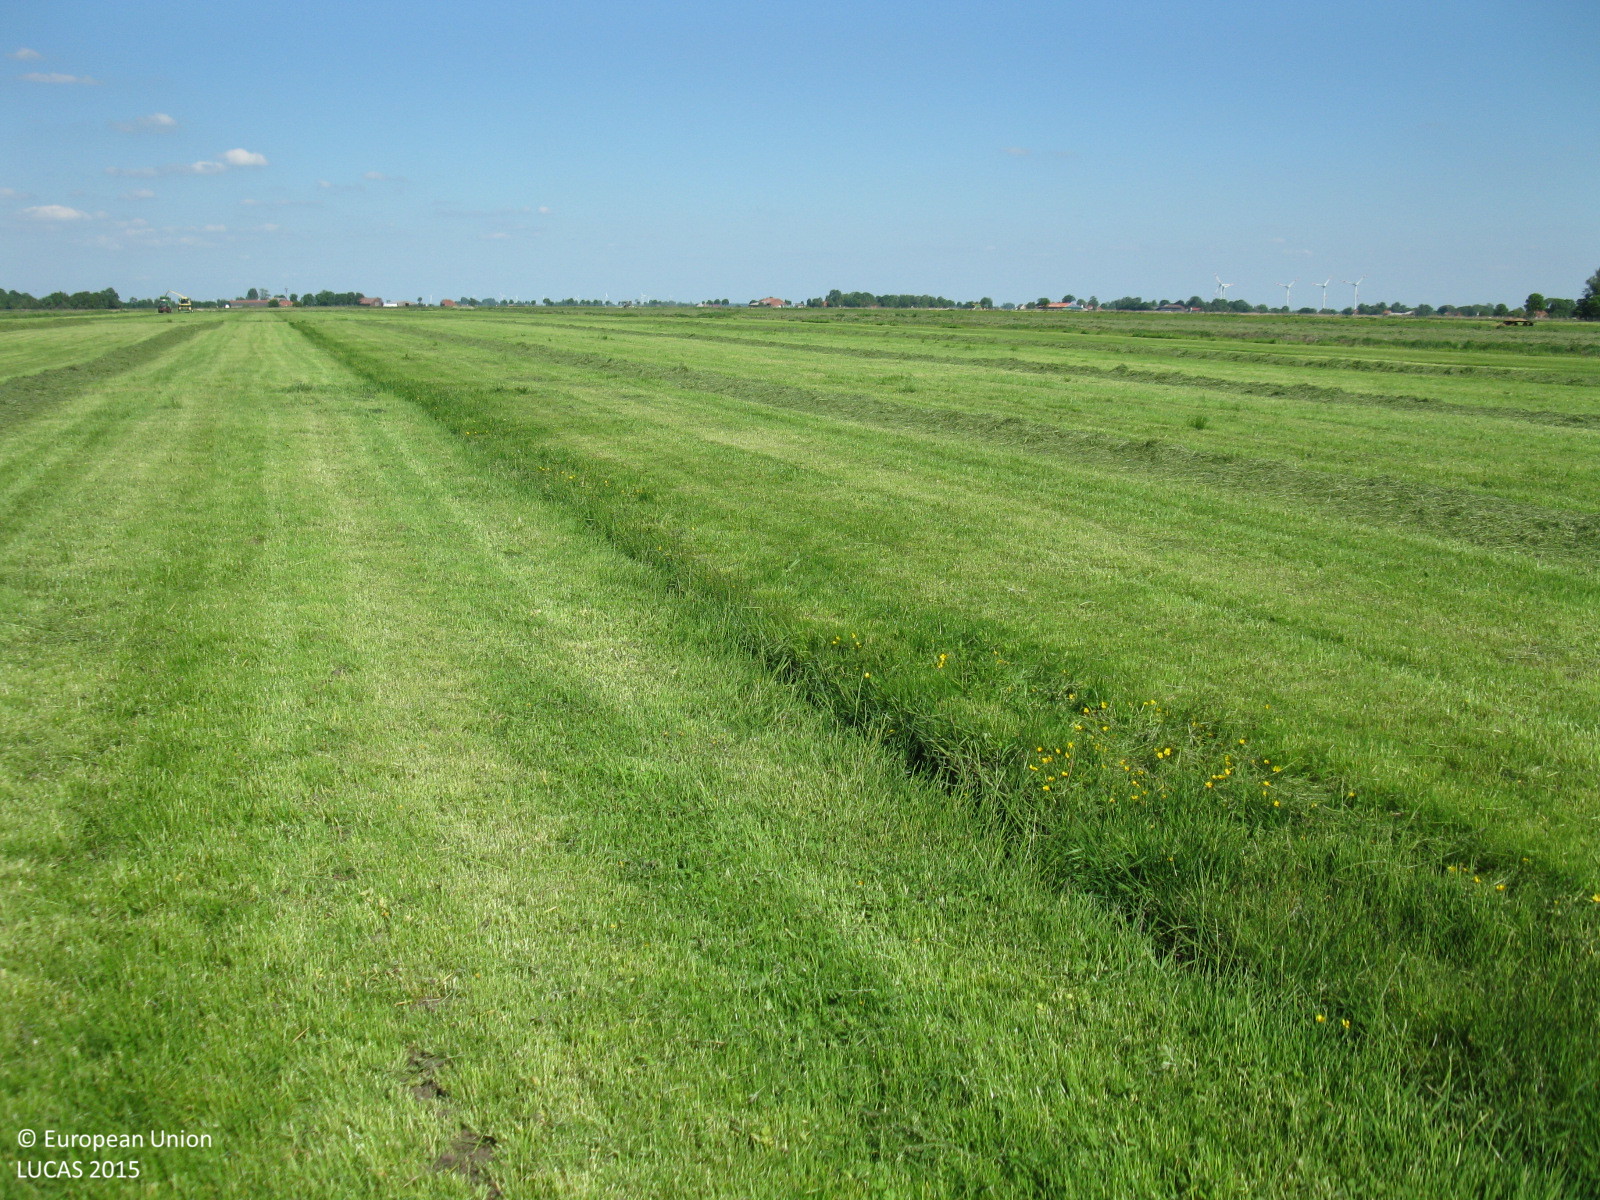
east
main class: Grassland
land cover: Grassland without tree/shrub cover
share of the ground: > 75 %
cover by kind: herbaceous plants 100 %
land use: Agriculture (excluding fallow land and kitchen gardens)
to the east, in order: Grassland without tree/shrub cover; Ditches and canals; Grassland without tree/shrub cover
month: June
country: DE
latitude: 53.2457
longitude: 7.2881
